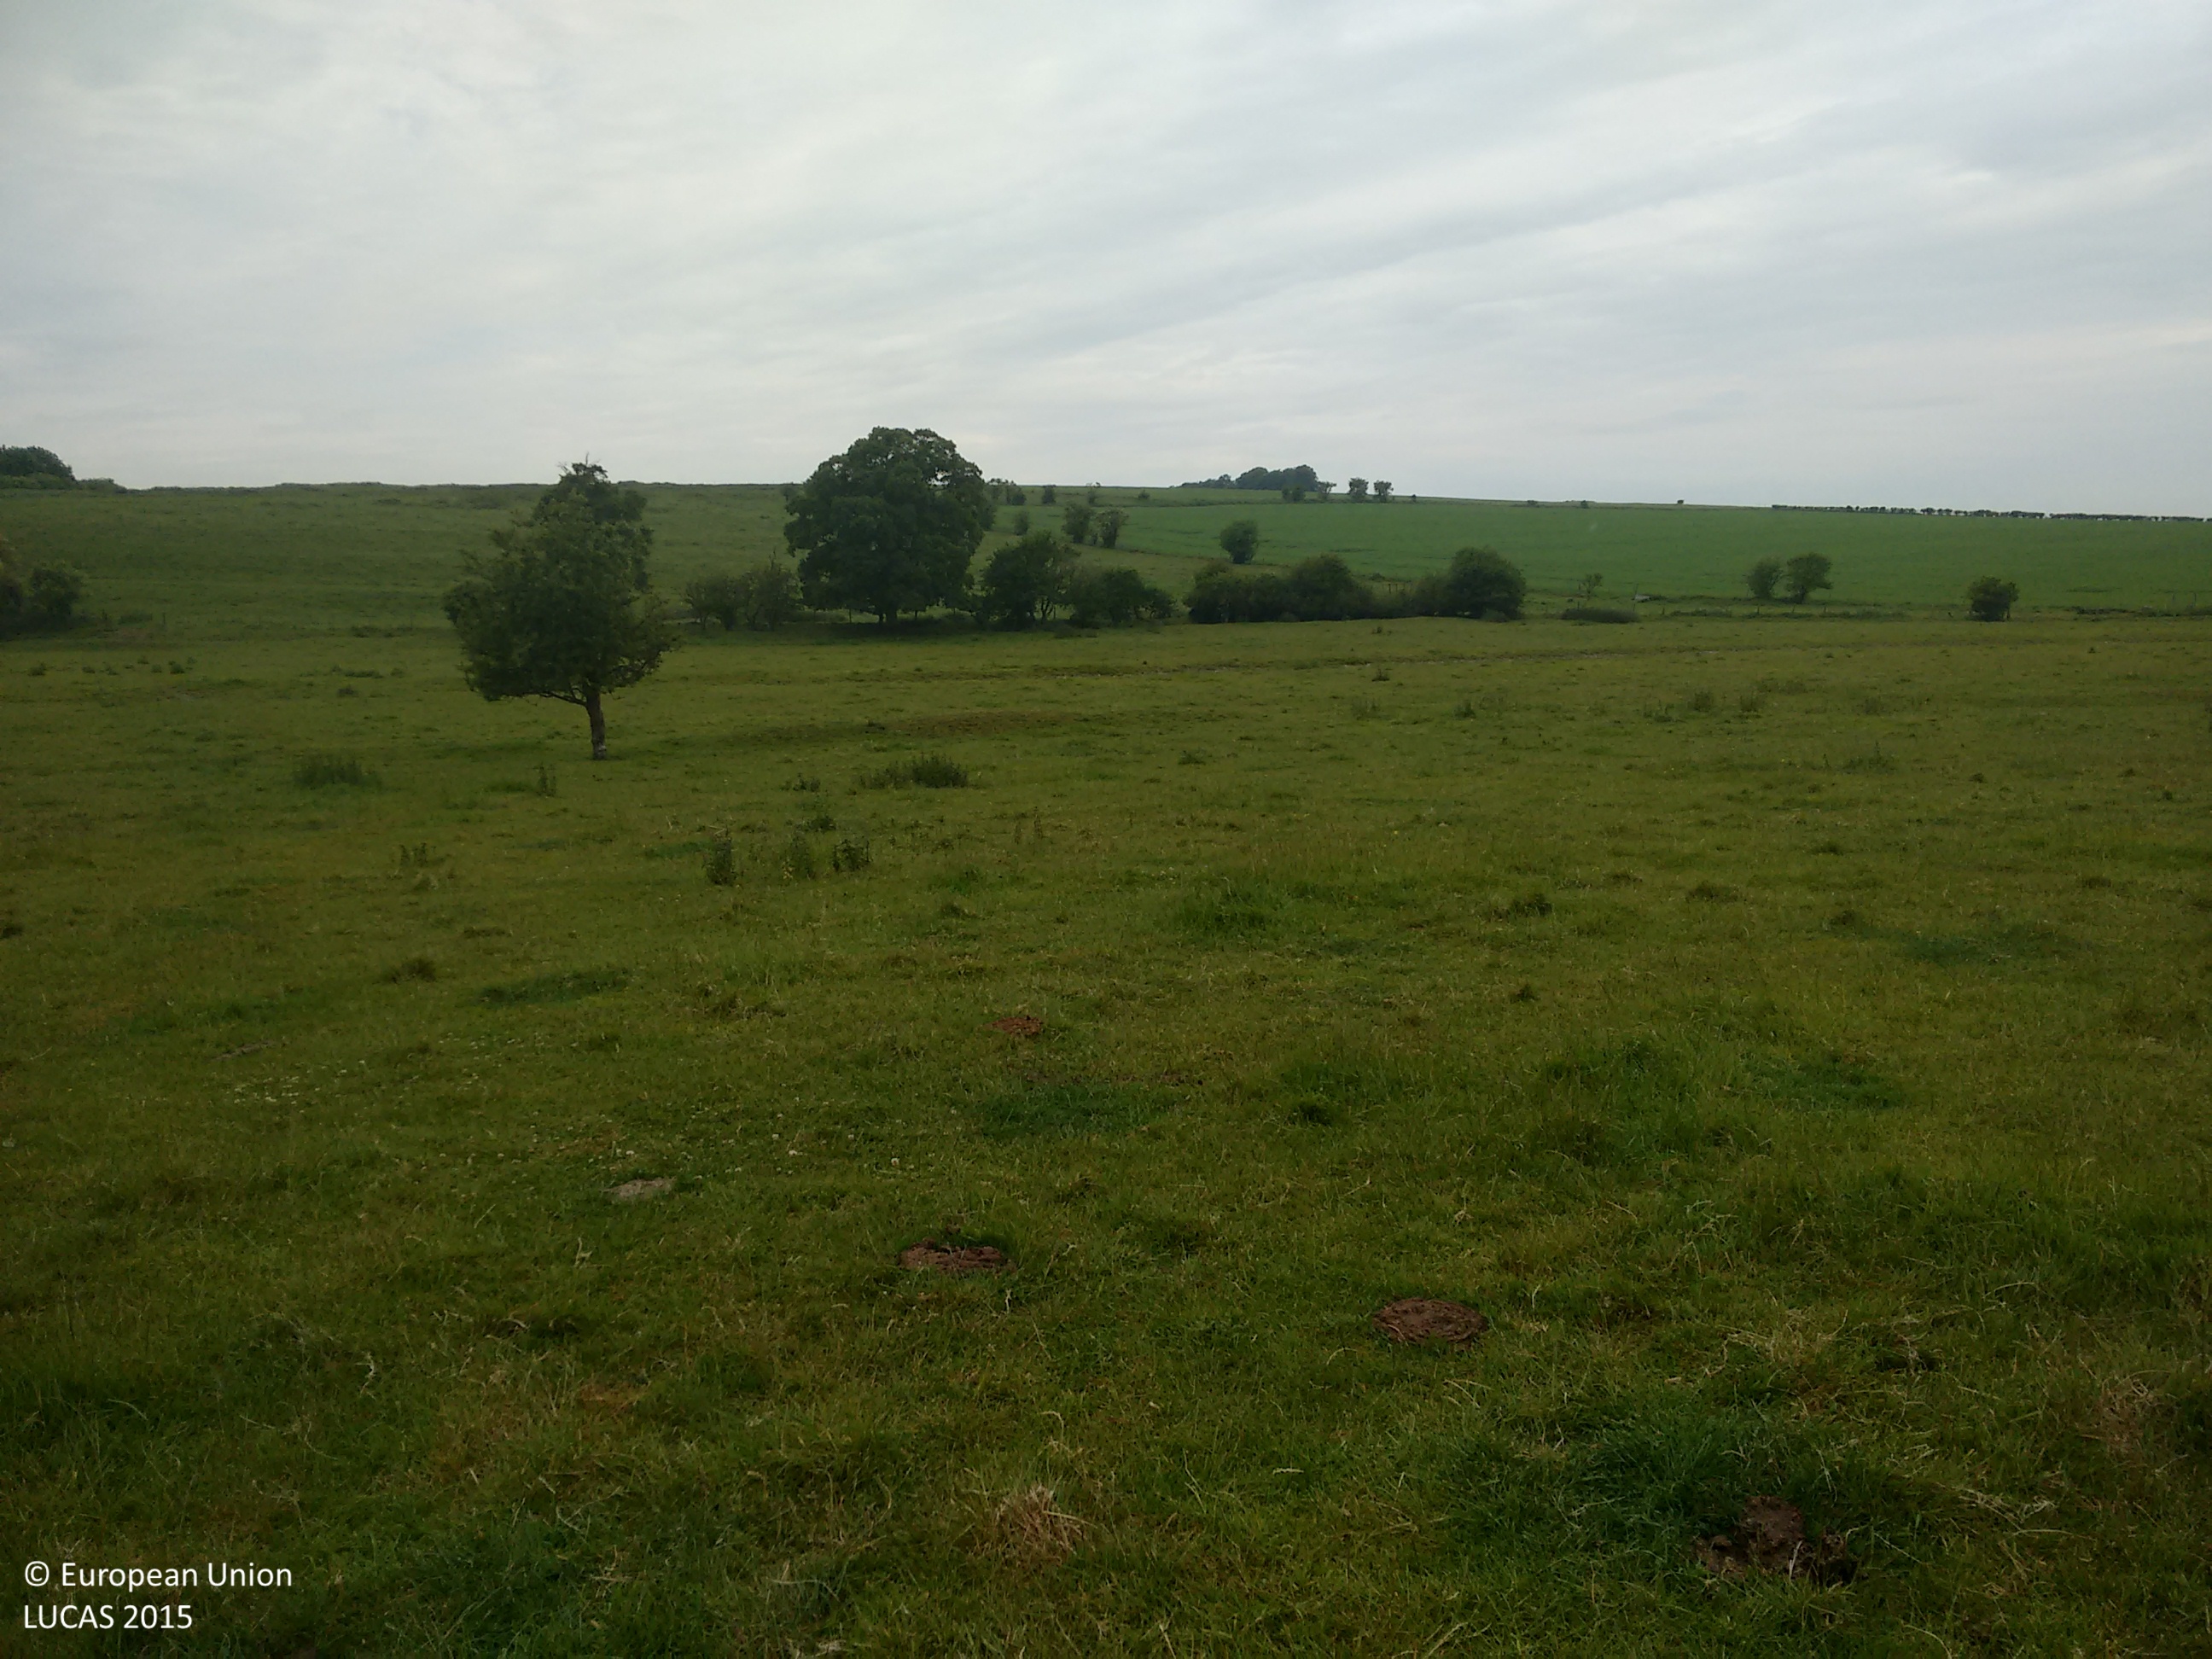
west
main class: Grassland
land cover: Grassland without tree/shrub cover
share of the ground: > 75 %
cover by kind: herbaceous plants 100 %
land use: Agriculture (excluding fallow land and kitchen gardens)
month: June
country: GB
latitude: 51.1778
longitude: -1.8866
